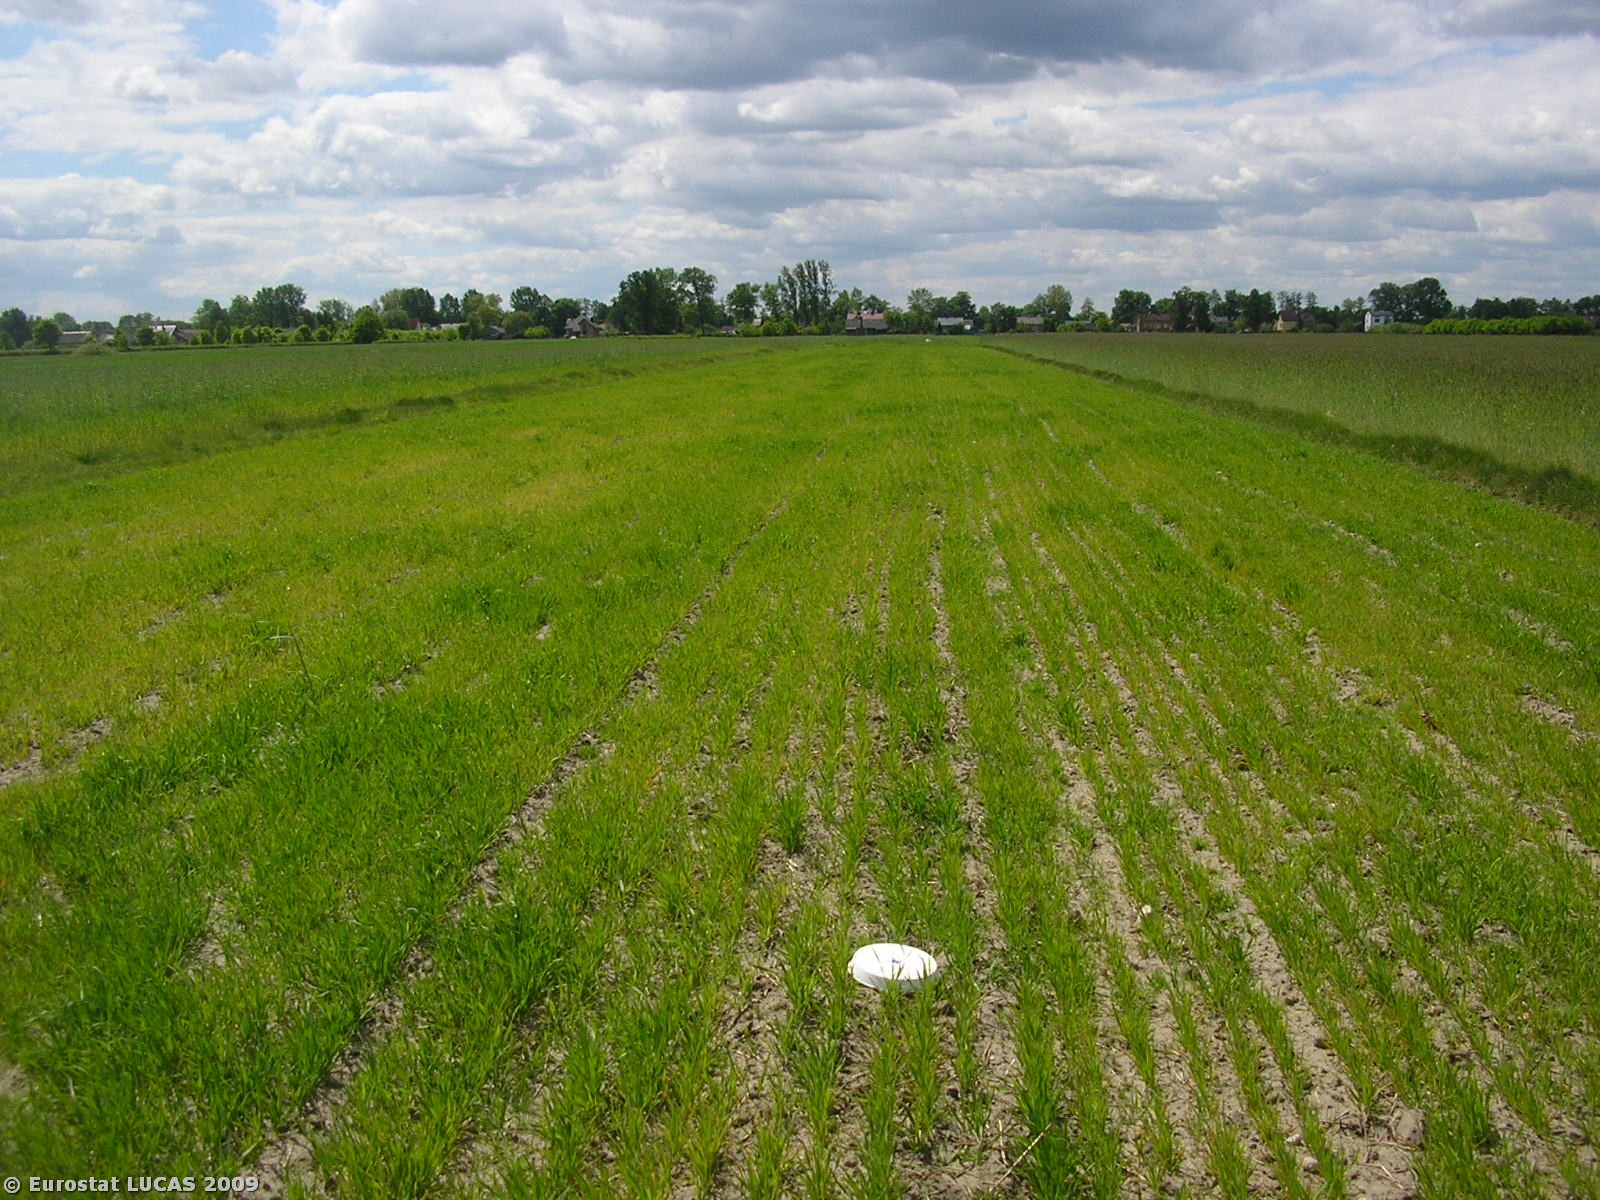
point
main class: Cropland
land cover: Oats
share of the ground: 10 - 25 %
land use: Agriculture (excluding fallow land and kitchen gardens)
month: May
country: PL
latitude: 51.9848
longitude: 20.0659
